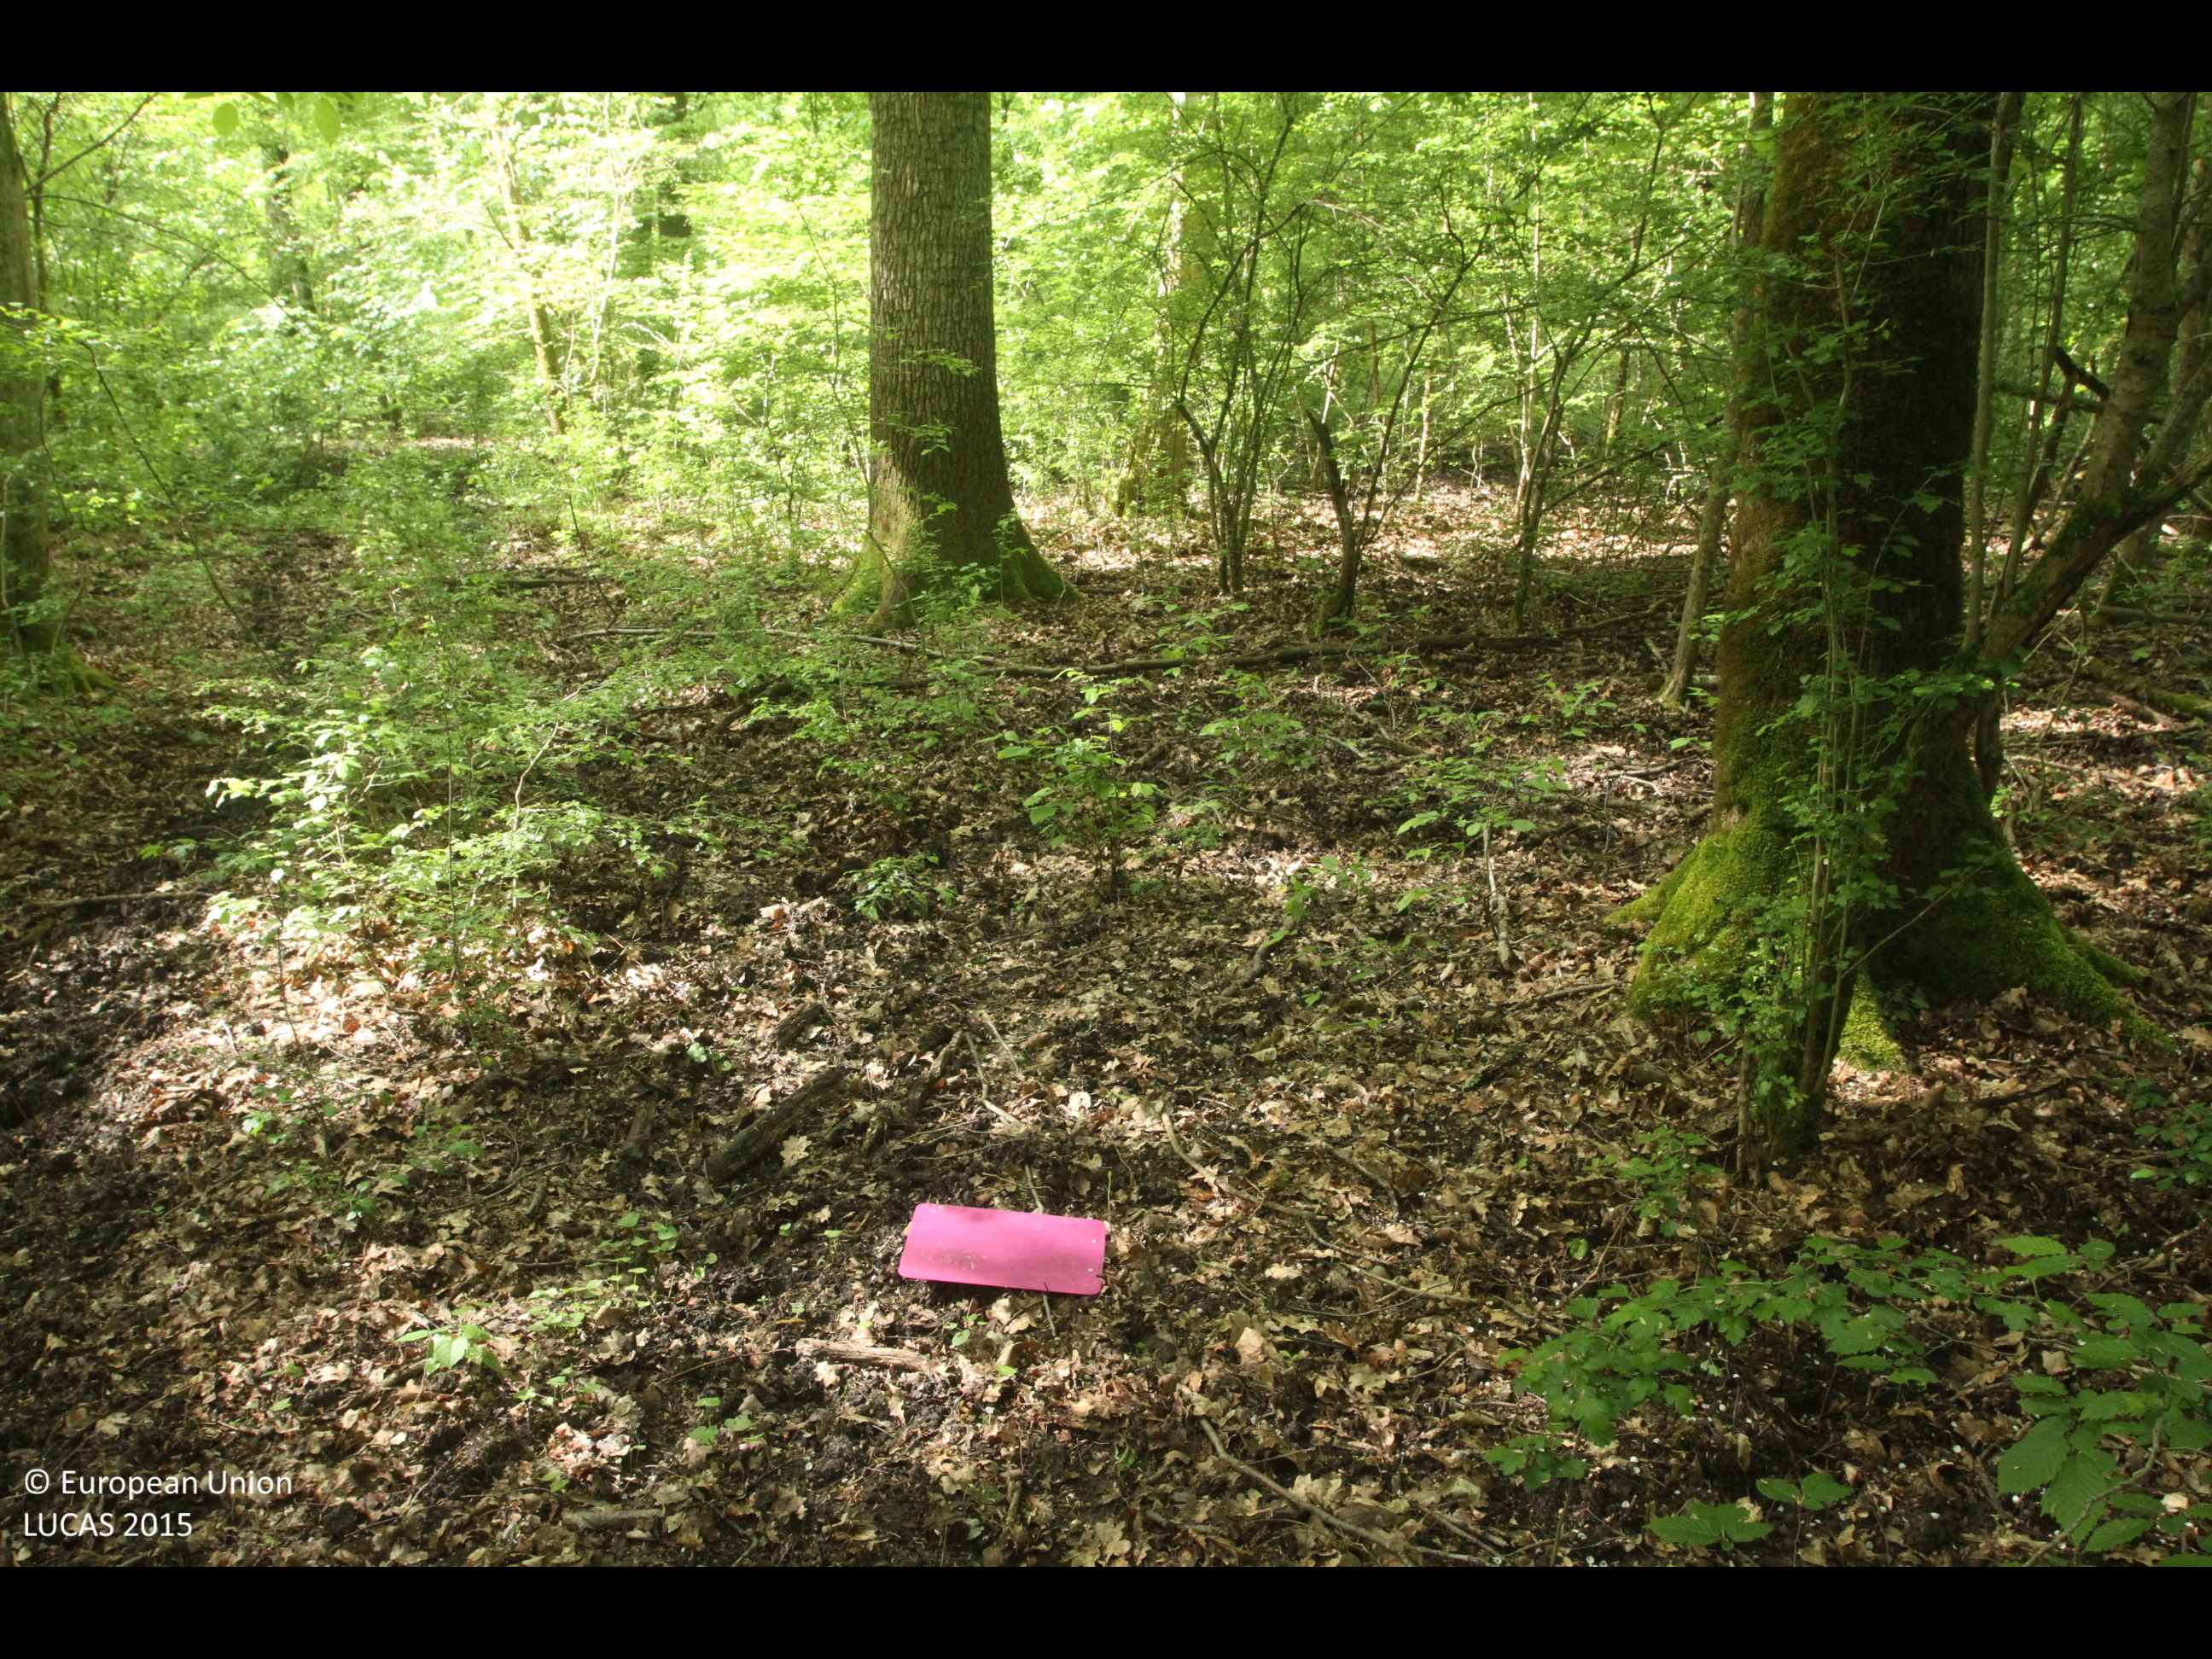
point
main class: Woodland
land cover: Broadleaved woodland
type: mesophytic deciduous forest
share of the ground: > 75 %
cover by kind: broadleaved forest trees 100 %
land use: Forestry
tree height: > 5 m
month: April
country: HR
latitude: 45.0260
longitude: 19.0312
